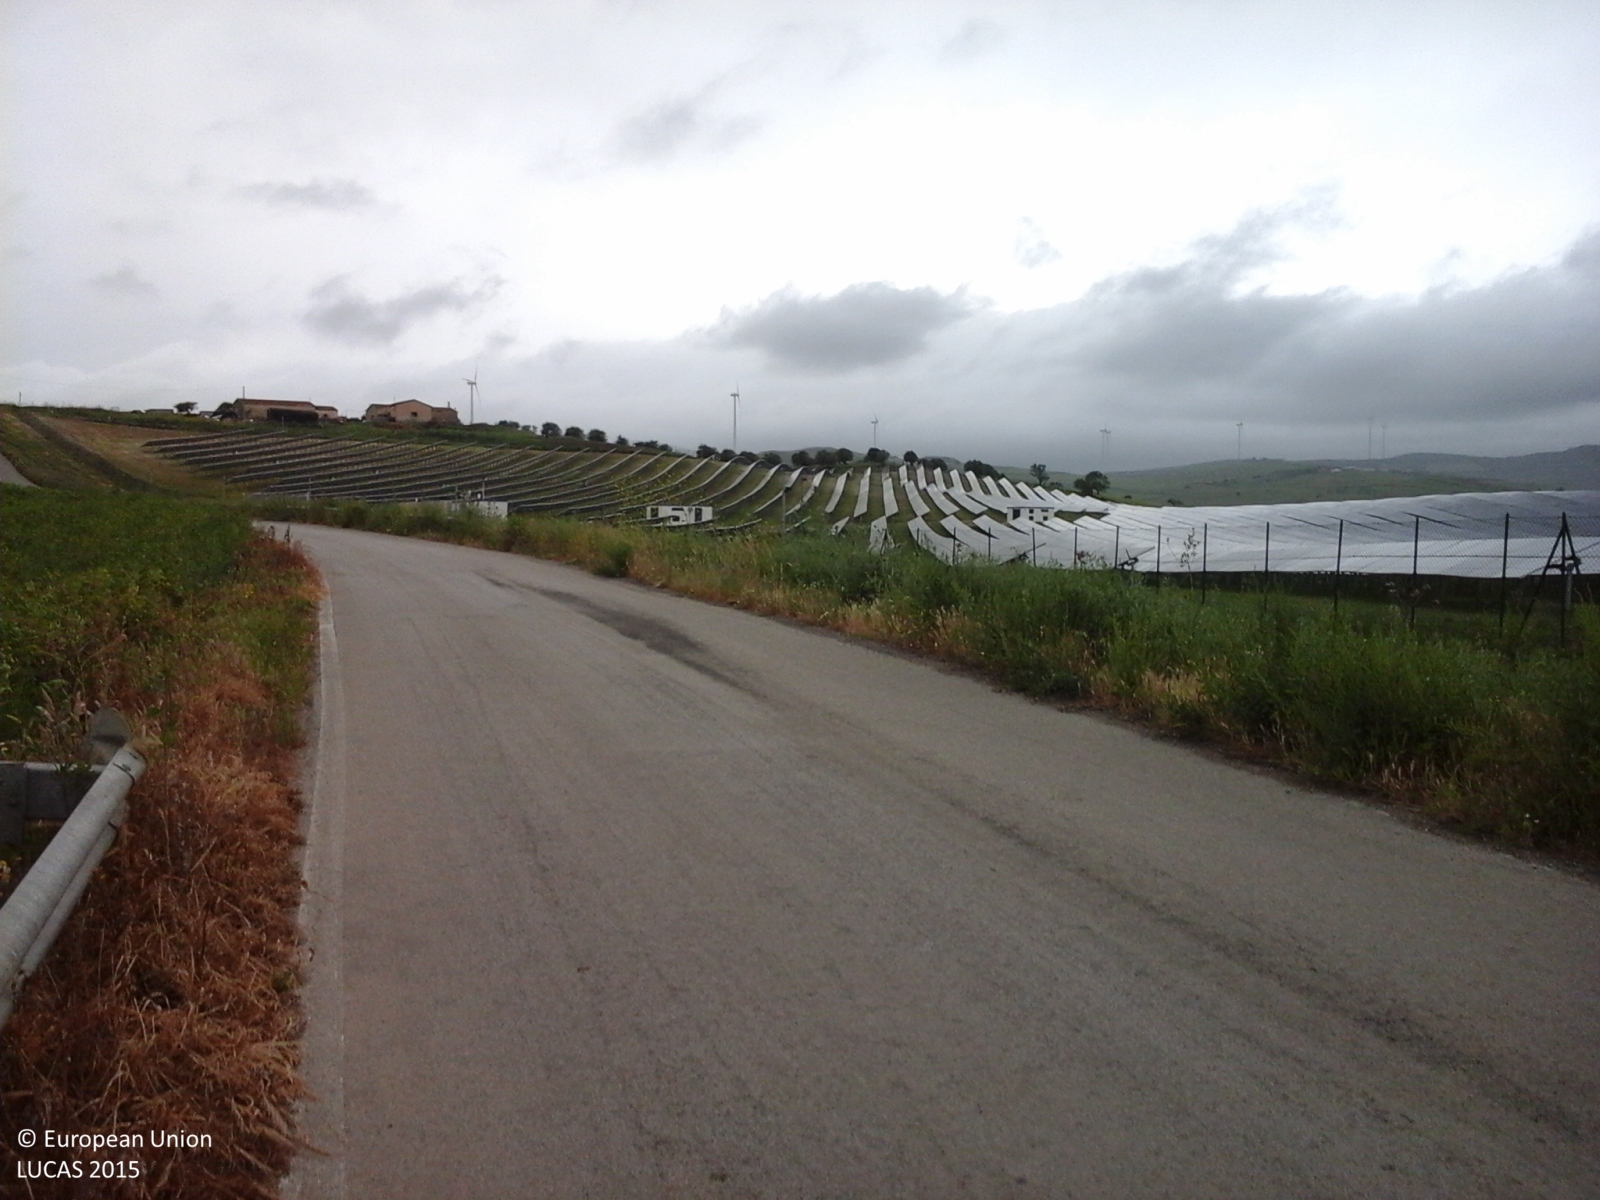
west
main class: Cropland
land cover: Temporary grasslands
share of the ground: > 75 %
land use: Agriculture (excluding fallow land and kitchen gardens)
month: May
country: IT
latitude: 37.7126
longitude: 13.6824
